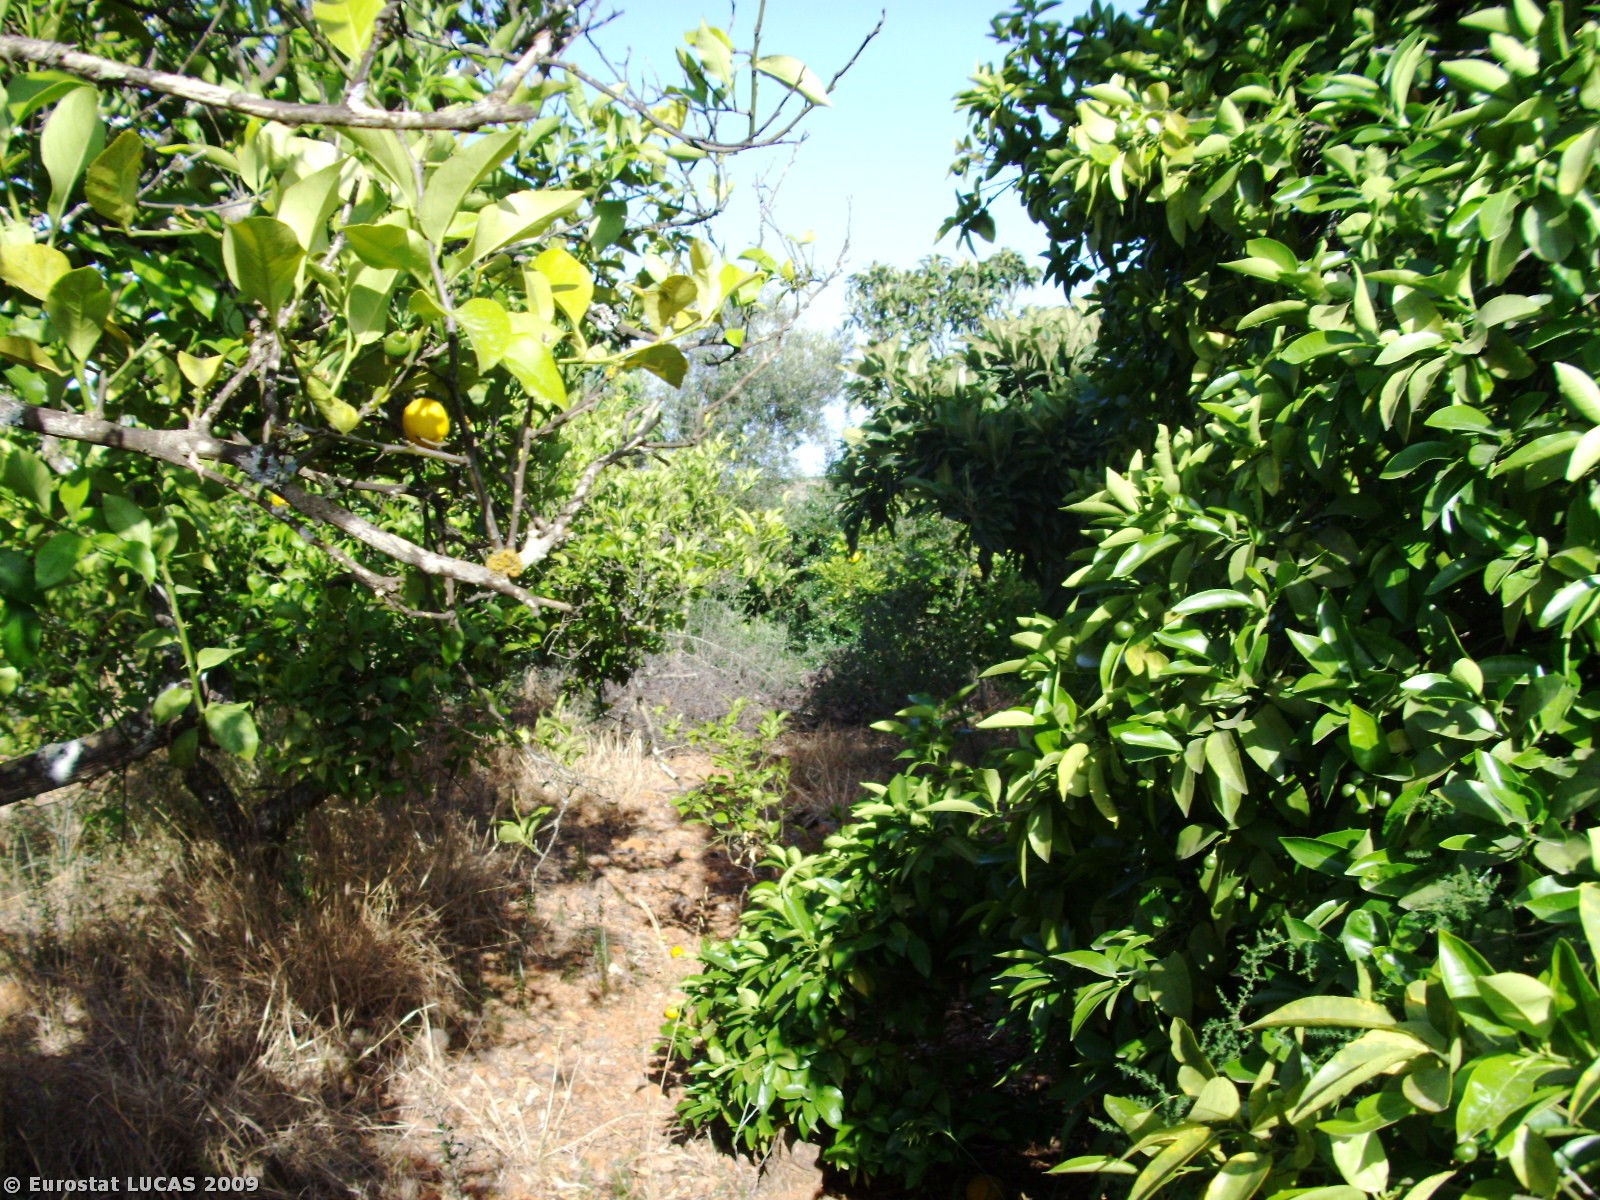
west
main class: Cropland
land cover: Other citrus fruit
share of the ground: 25 - 50 %
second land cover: Spontaneously vegetated surfaces
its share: 50 - 75 %
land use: Agriculture (excluding fallow land and kitchen gardens)
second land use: Fallow land
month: May
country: PT
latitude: 37.1959
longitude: -8.3981
